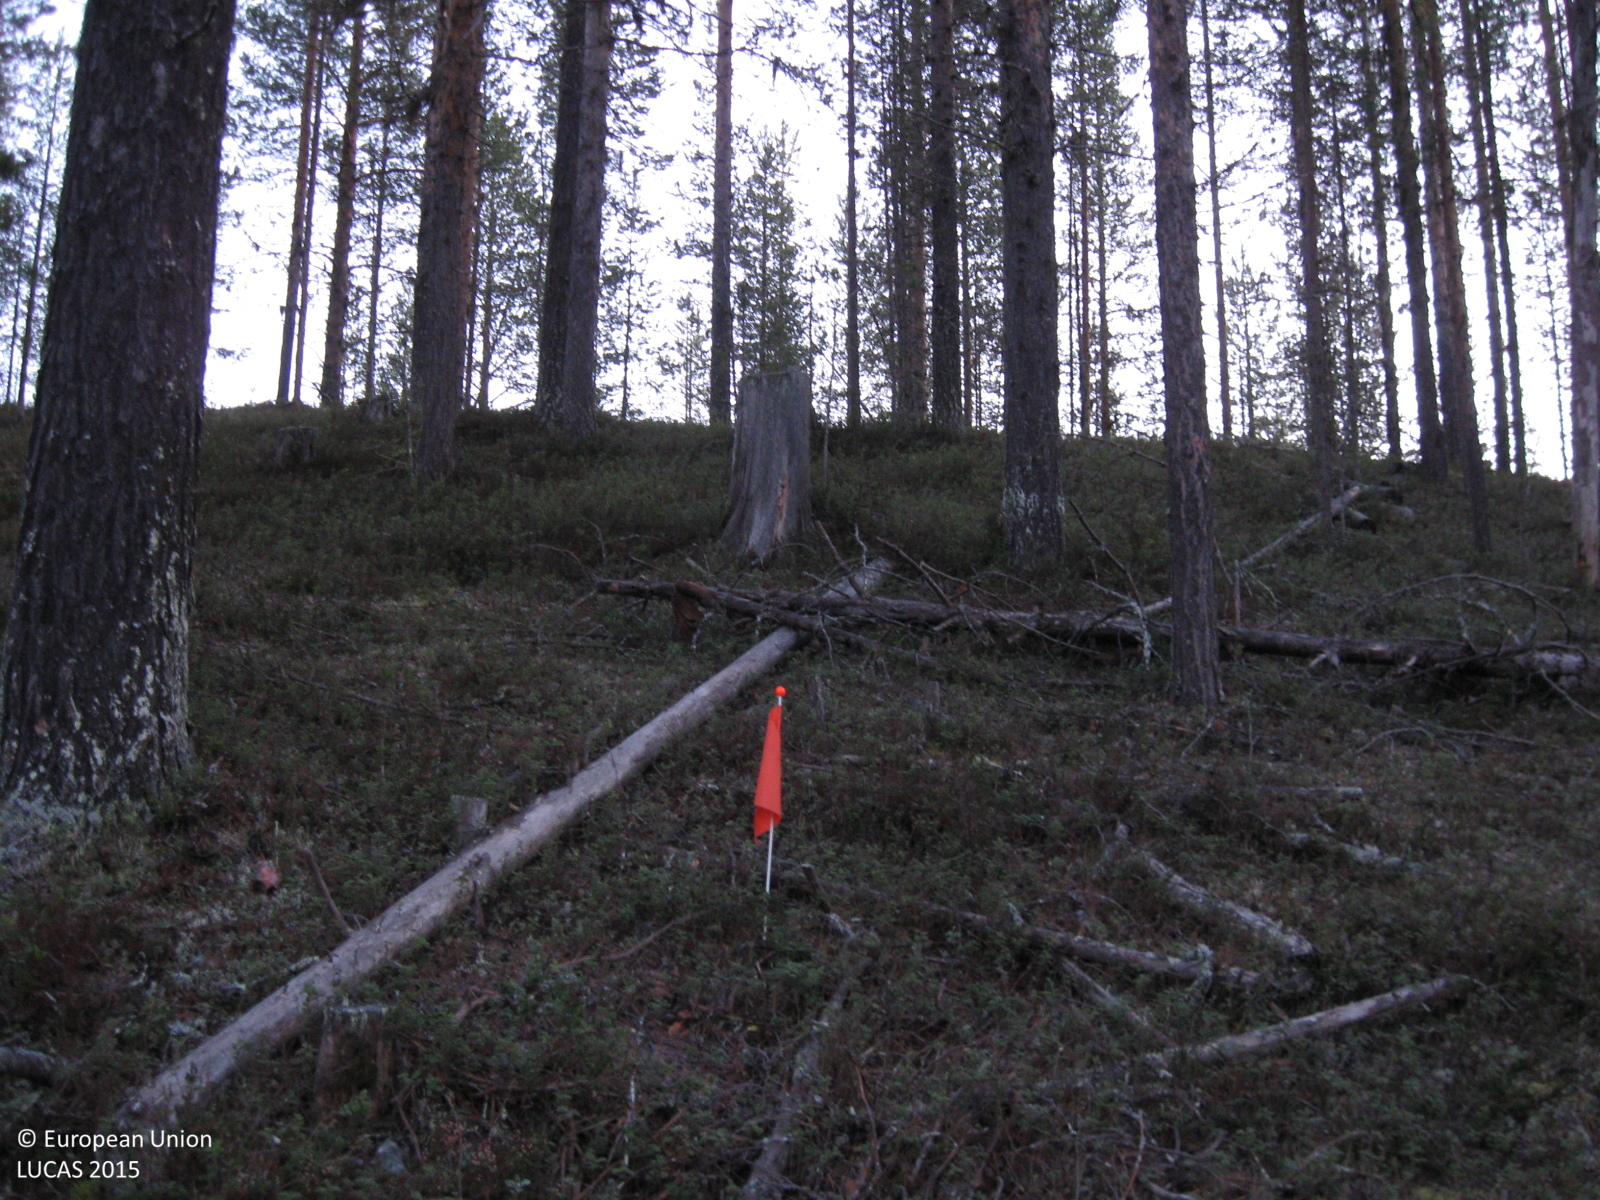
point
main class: Woodland
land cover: Pine dominated coniferous woodland
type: boreal forest
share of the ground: 50 - 75 %
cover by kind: coniferous forest trees 70 %, shrubs 20 %, herbaceous plants 5 %, lichens and mosses 5 %
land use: Forestry
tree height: > 5 m
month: October
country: SE
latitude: 66.4847
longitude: 20.9871
